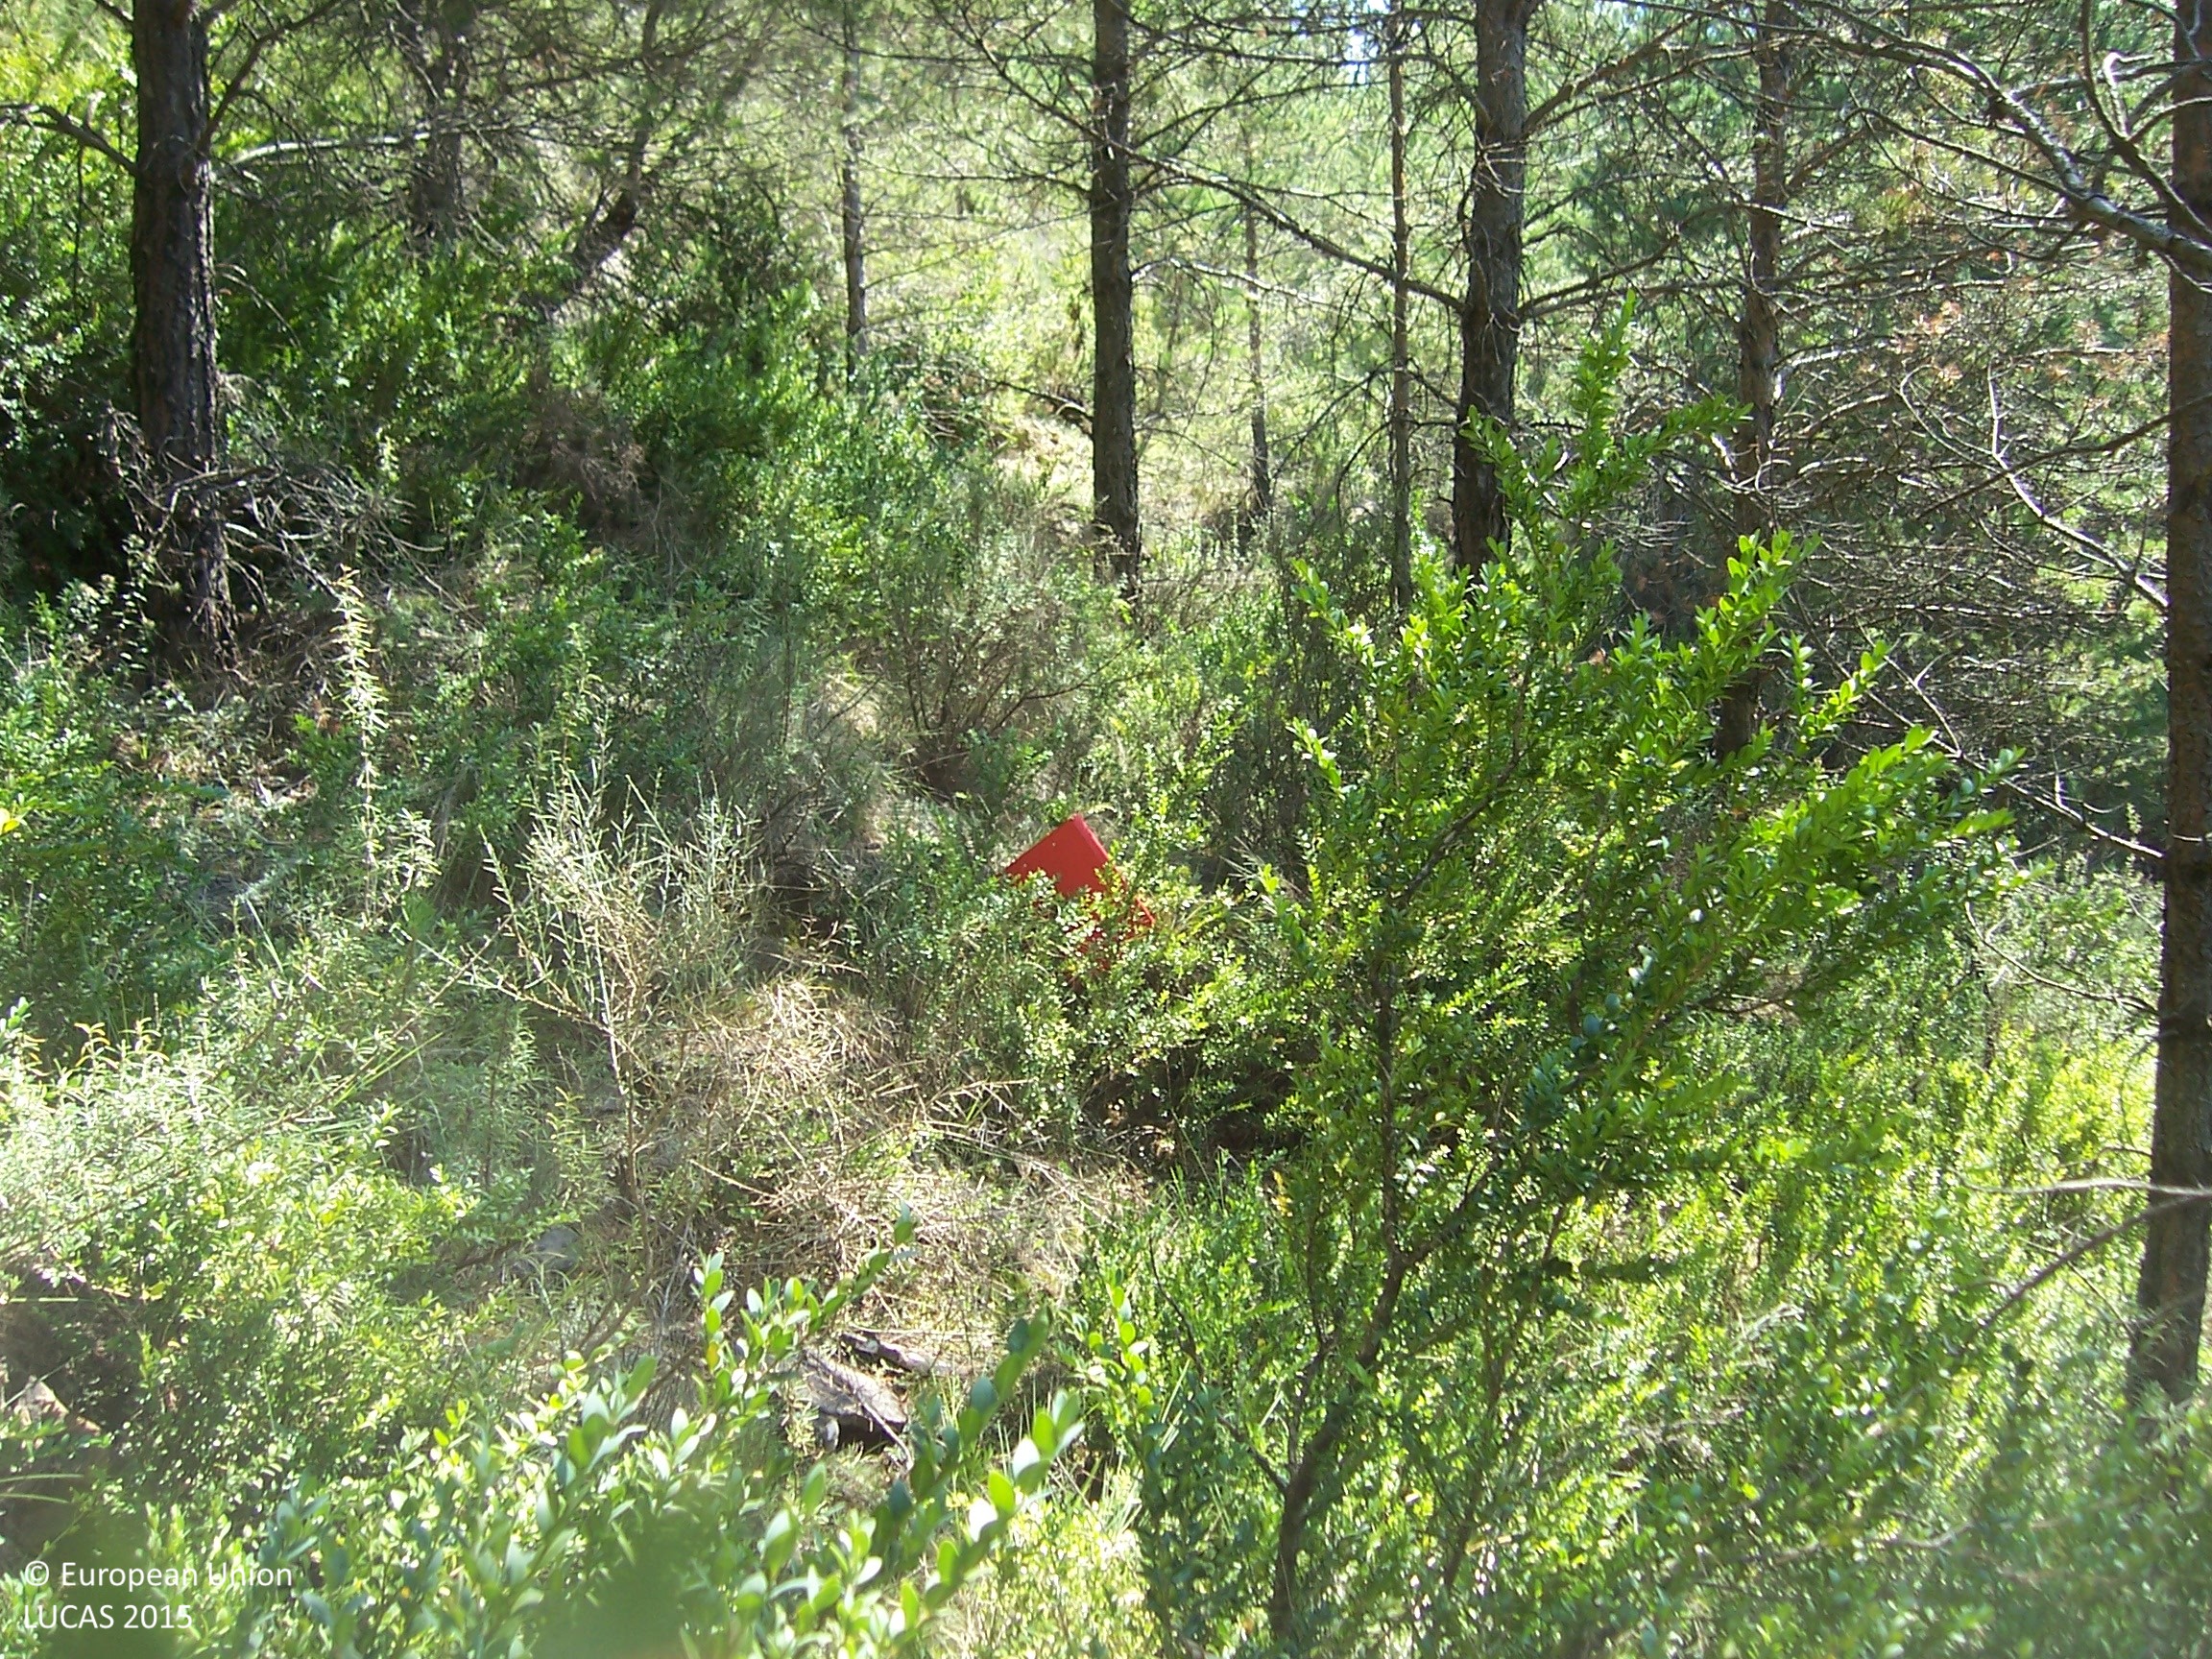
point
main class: Woodland
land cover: Pine dominated coniferous woodland
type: coniferous forest of the mediterranean region
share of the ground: > 75 %
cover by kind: coniferous forest trees 95 %, shrubs 5 %
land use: Forestry
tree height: > 5 m
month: August
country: ES
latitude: 42.3336
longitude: 0.3078
